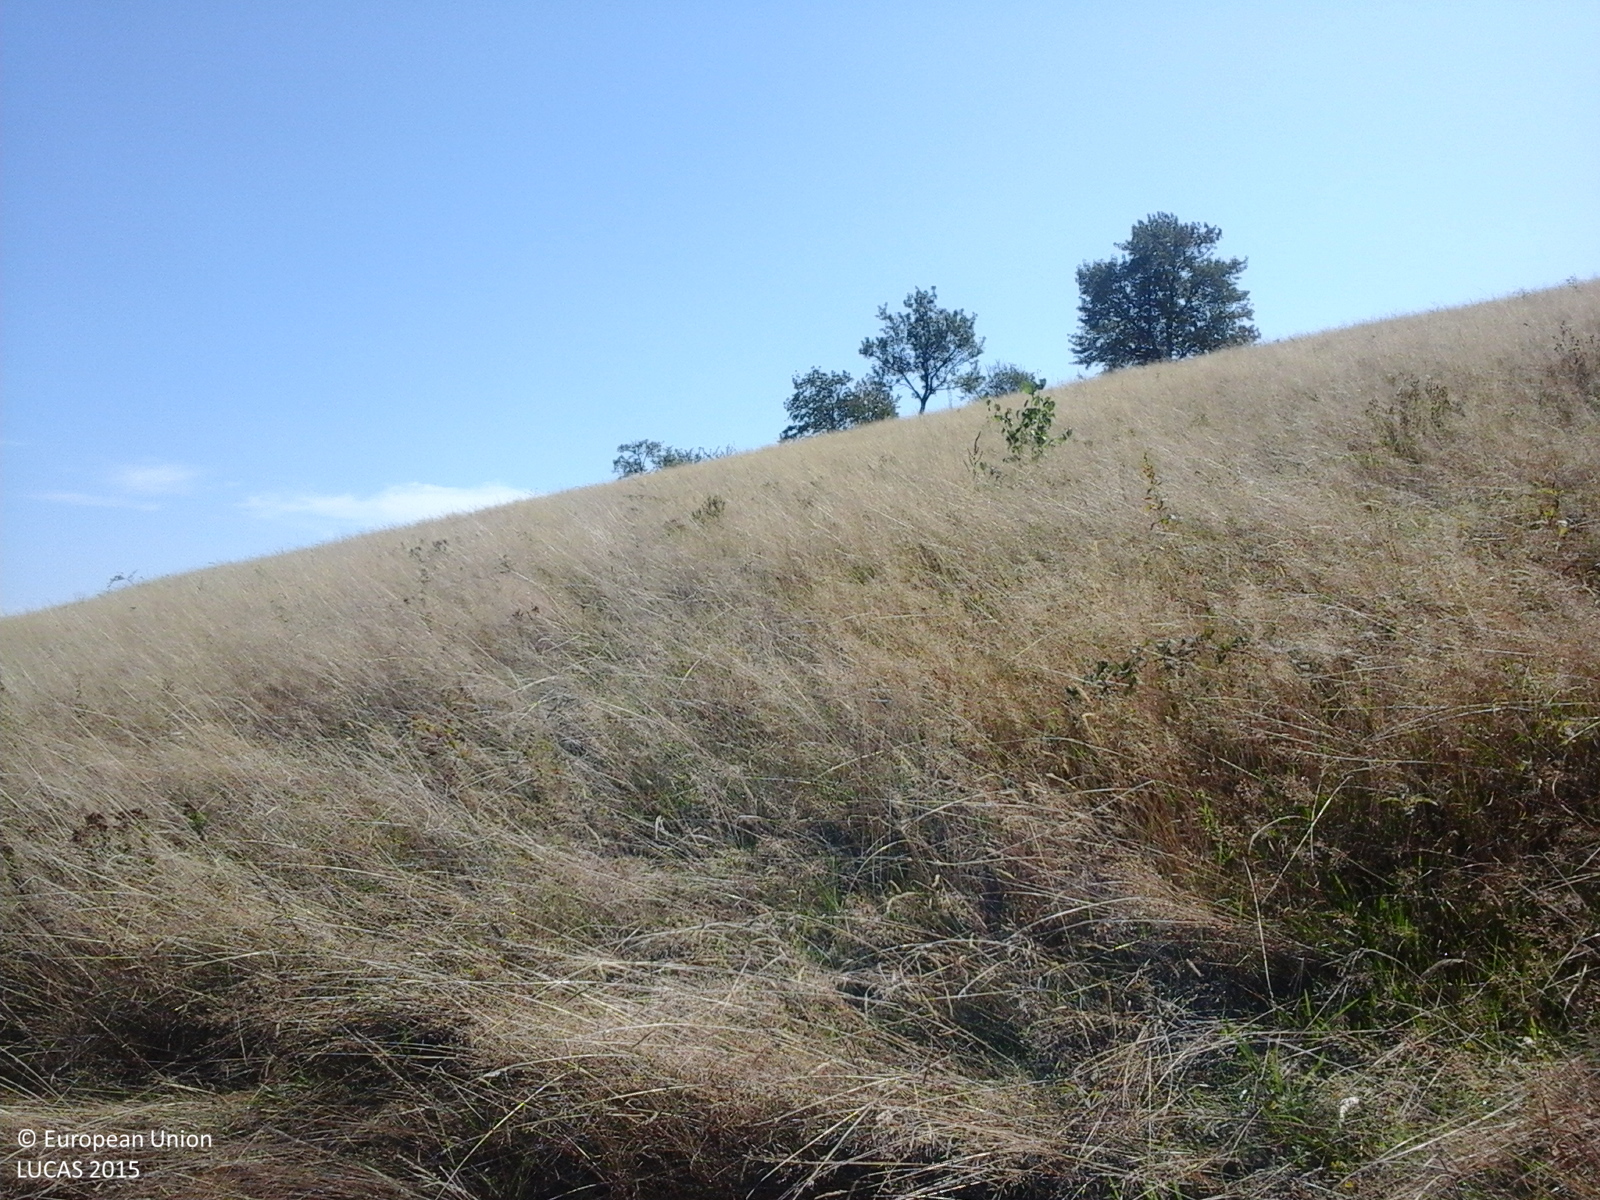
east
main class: Grassland
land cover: Grassland with sparse tree/shrub cover
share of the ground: > 75 %
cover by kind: herbaceous plants 85 %, shrubs 10 %, broadleaved forest trees 5 %
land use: Agriculture (excluding fallow land and kitchen gardens)
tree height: < 5 m
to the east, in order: Grassland with sparse tree/shrub cover; Grassland without tree/shrub cover; Potatoes; Grassland without tree/shrub cover; Broadleaved woodland
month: September
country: RO
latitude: 47.1043
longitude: 22.5338
